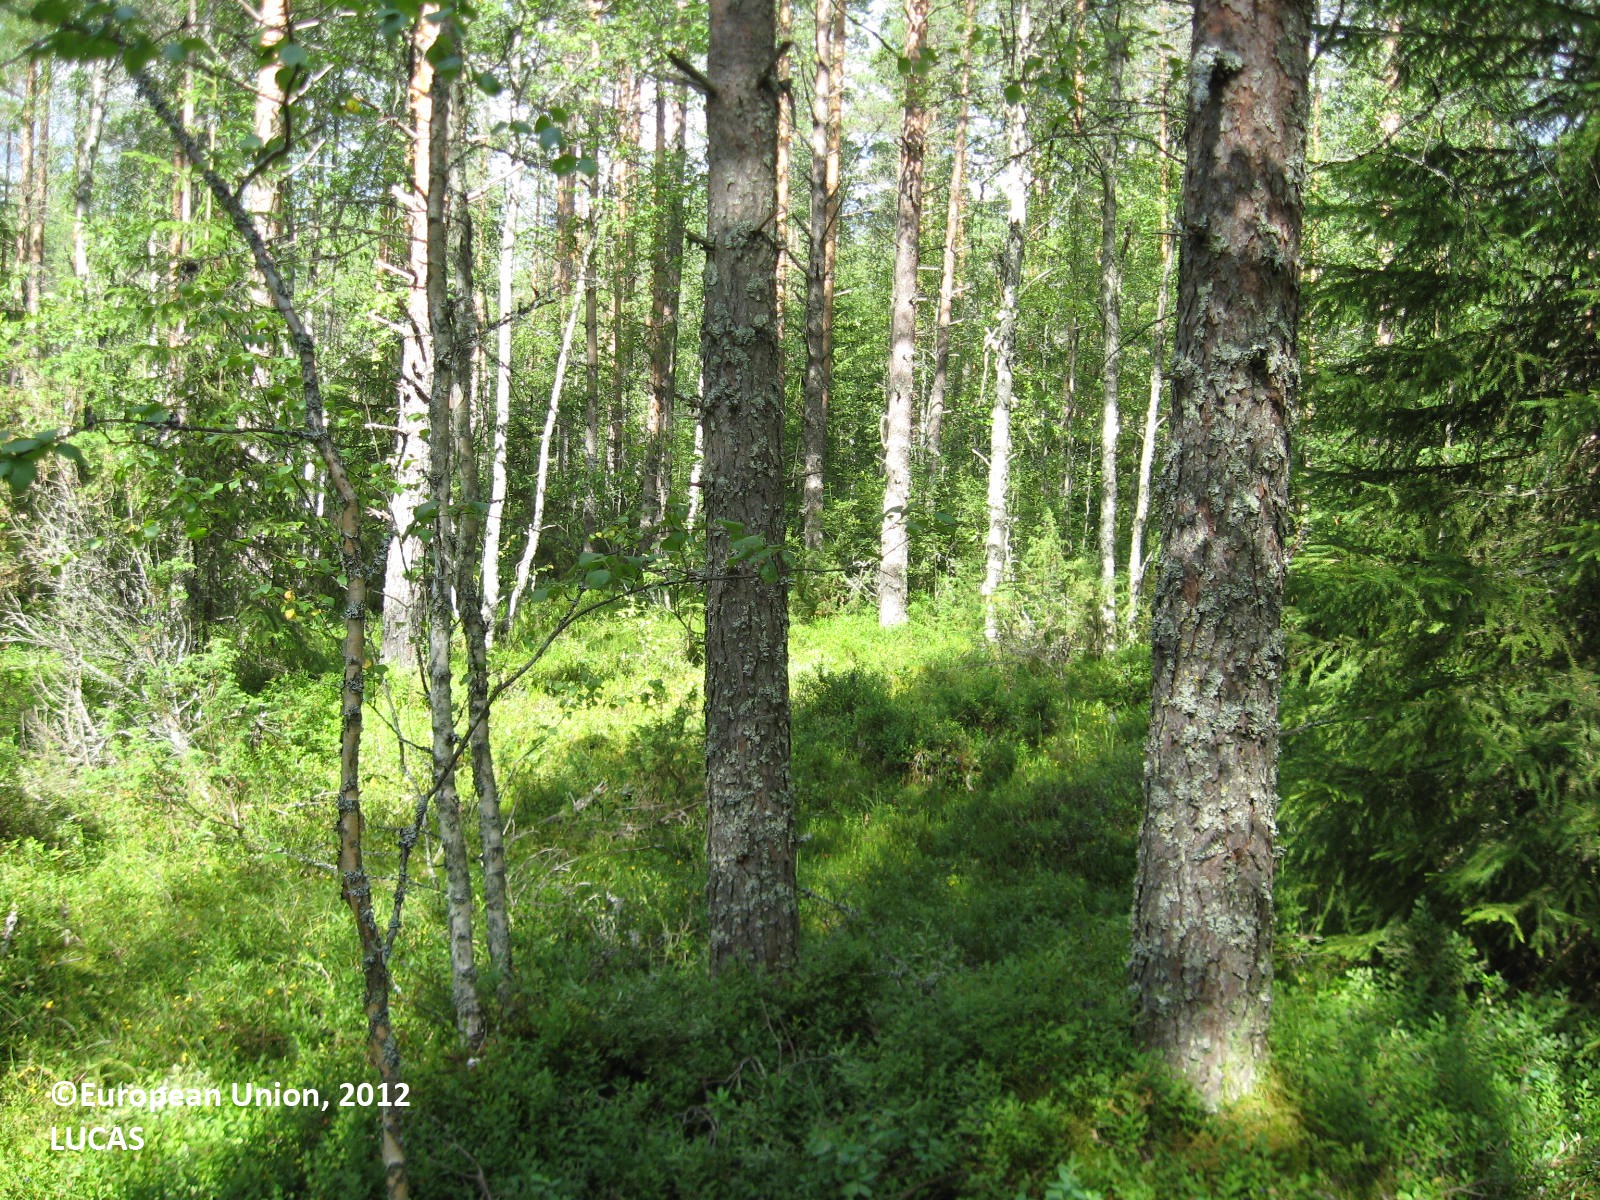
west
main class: Woodland
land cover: Pine dominated mixed woodland
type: boreal forest
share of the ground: > 75 %
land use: Forestry
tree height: > 5 m
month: July
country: FI
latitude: 62.1028
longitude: 22.3371
